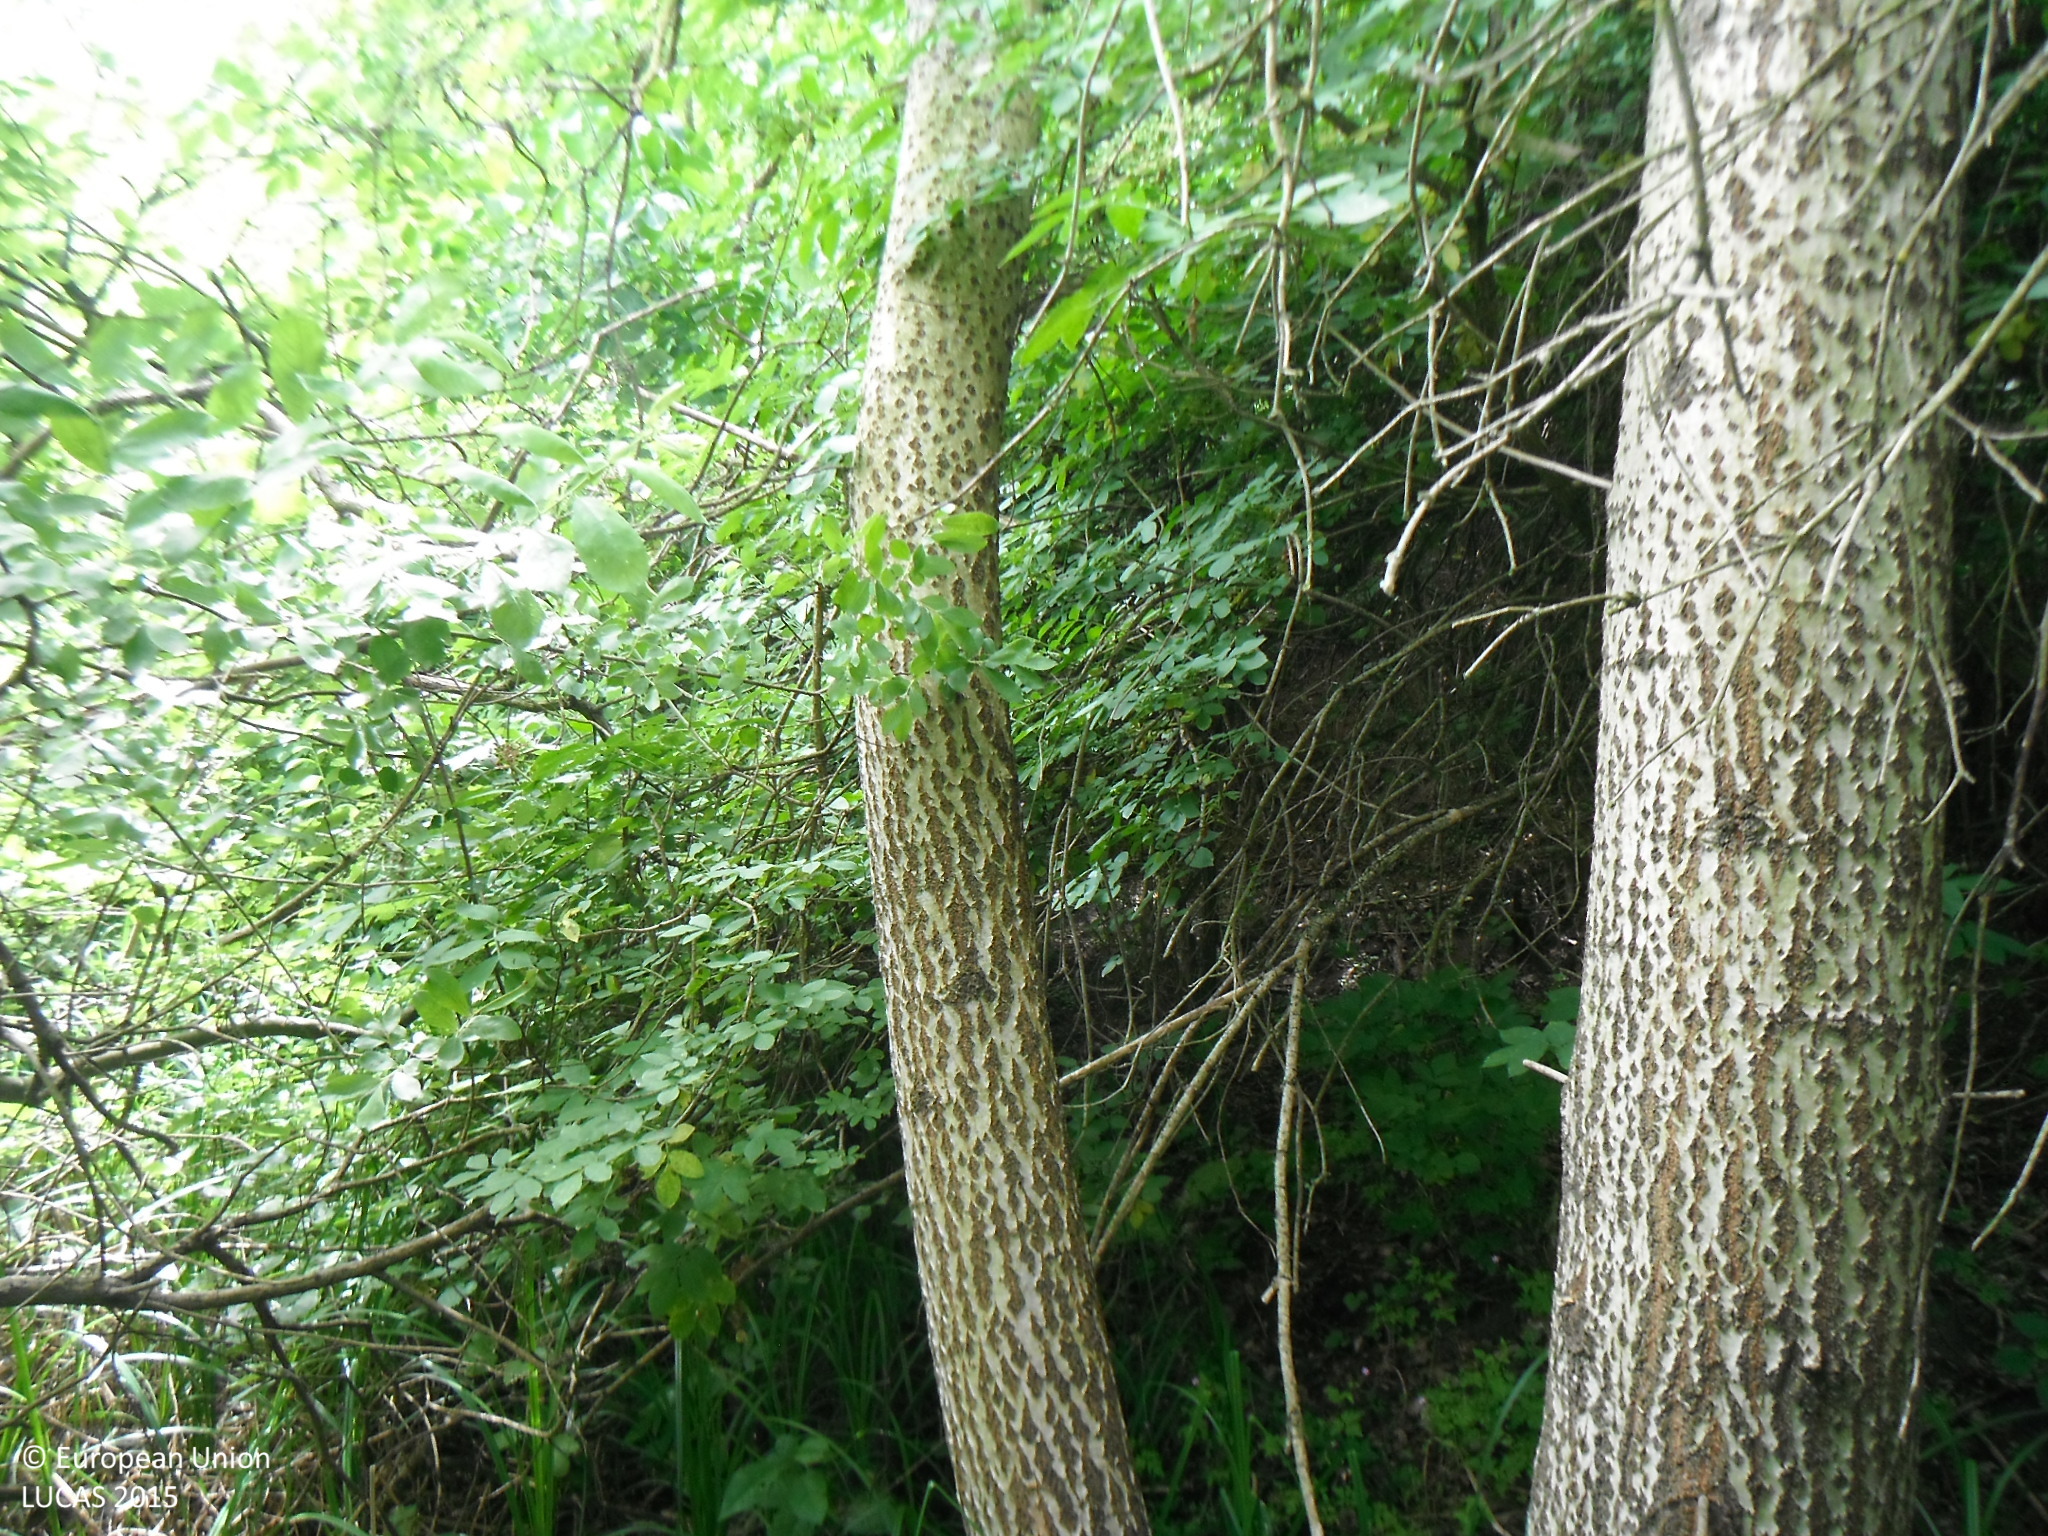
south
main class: Woodland
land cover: Broadleaved woodland
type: mesophytic deciduous forest
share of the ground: 50 - 75 %
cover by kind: broadleaved forest trees 55 %, shrubs 45 %
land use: Semi-natural and natural areas not in use
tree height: > 5 m
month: June
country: SK
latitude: 47.9165
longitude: 18.2160
